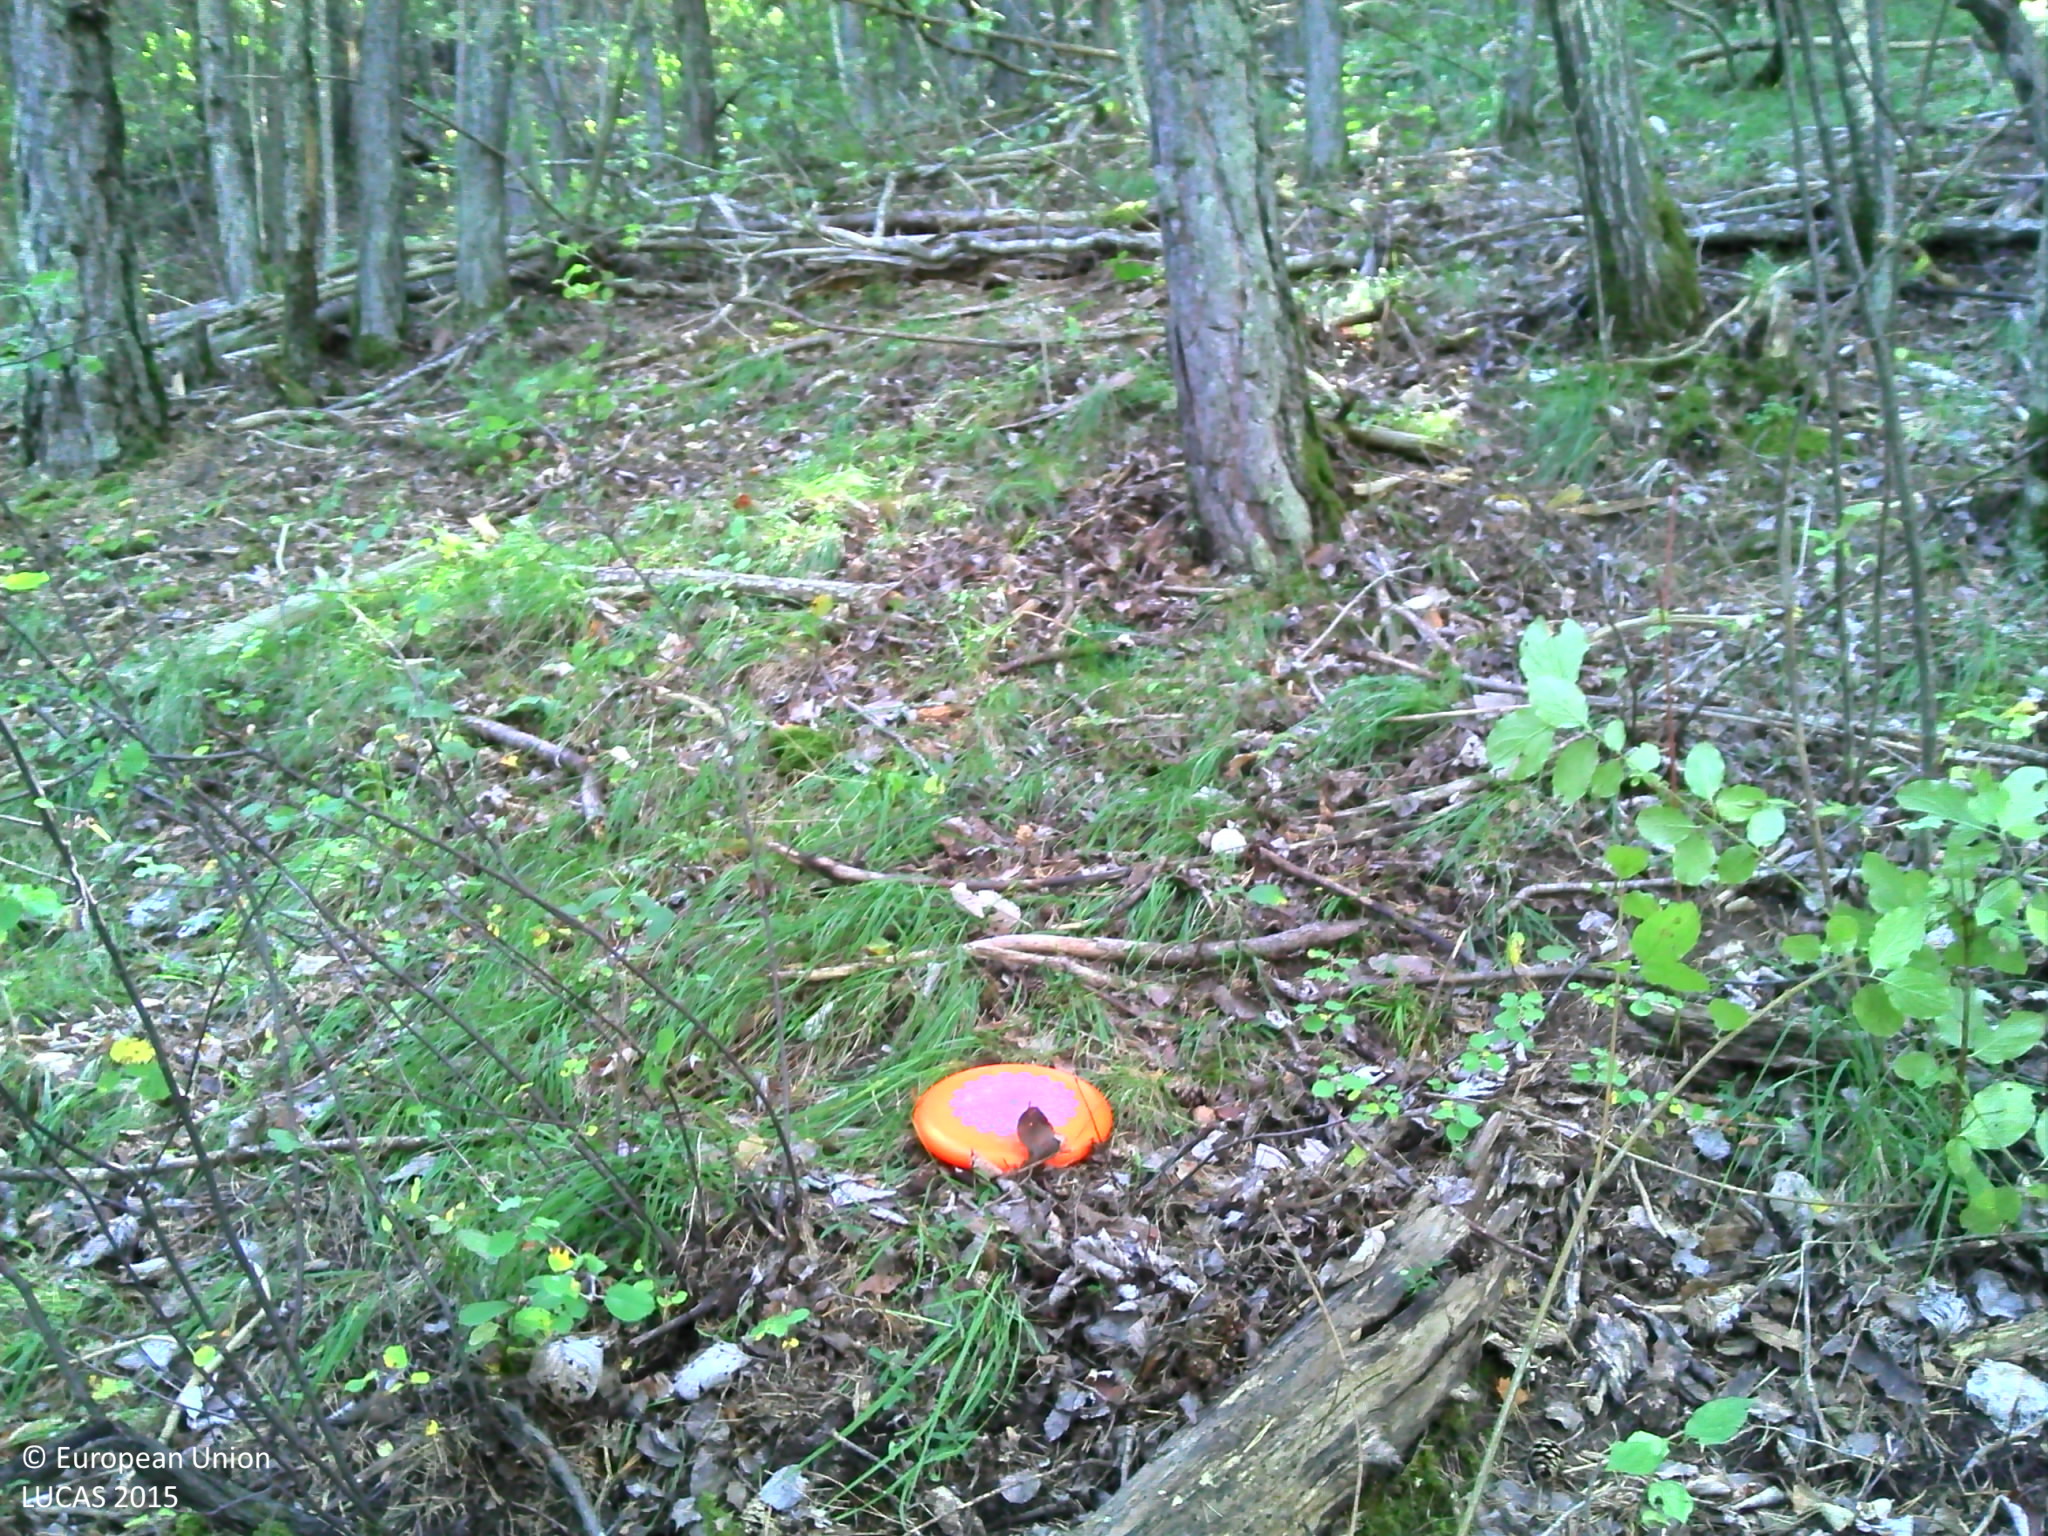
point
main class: Woodland
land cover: Pine dominated mixed woodland
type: hemiboreal forest and nemoral coniferous forest and mixed broadleaved-coniferous forest
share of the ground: > 75 %
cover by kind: coniferous forest trees 60 %, broadleaved forest trees 30 %, herbaceous plants 5 %, unconsolidated bare surface 5 %
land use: Forestry
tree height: > 5 m
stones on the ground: < 10 %
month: September
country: FR
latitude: 44.5235
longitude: 6.4205
